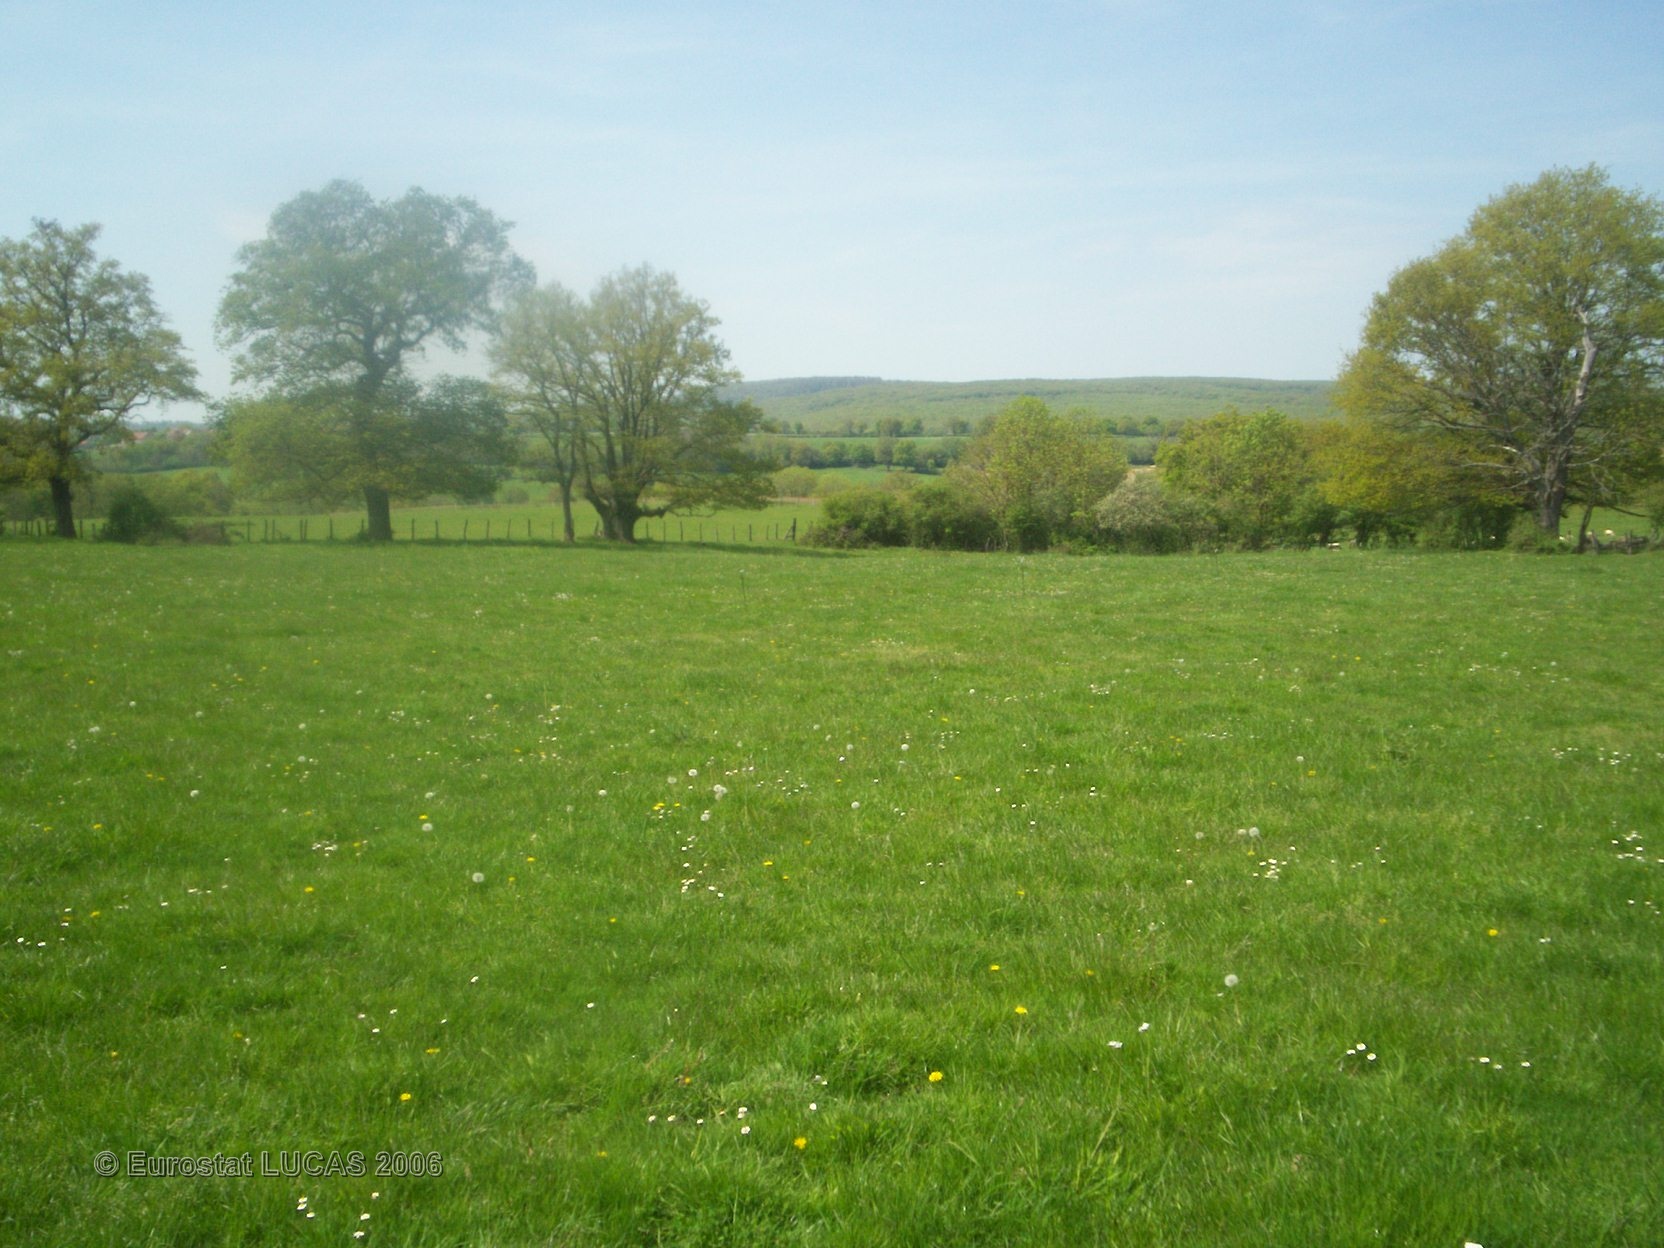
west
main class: Grassland
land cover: Grassland without tree/shrub cover
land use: Agriculture (excluding fallow land and kitchen gardens)
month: May
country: FR
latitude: 46.4935
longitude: 3.1577
